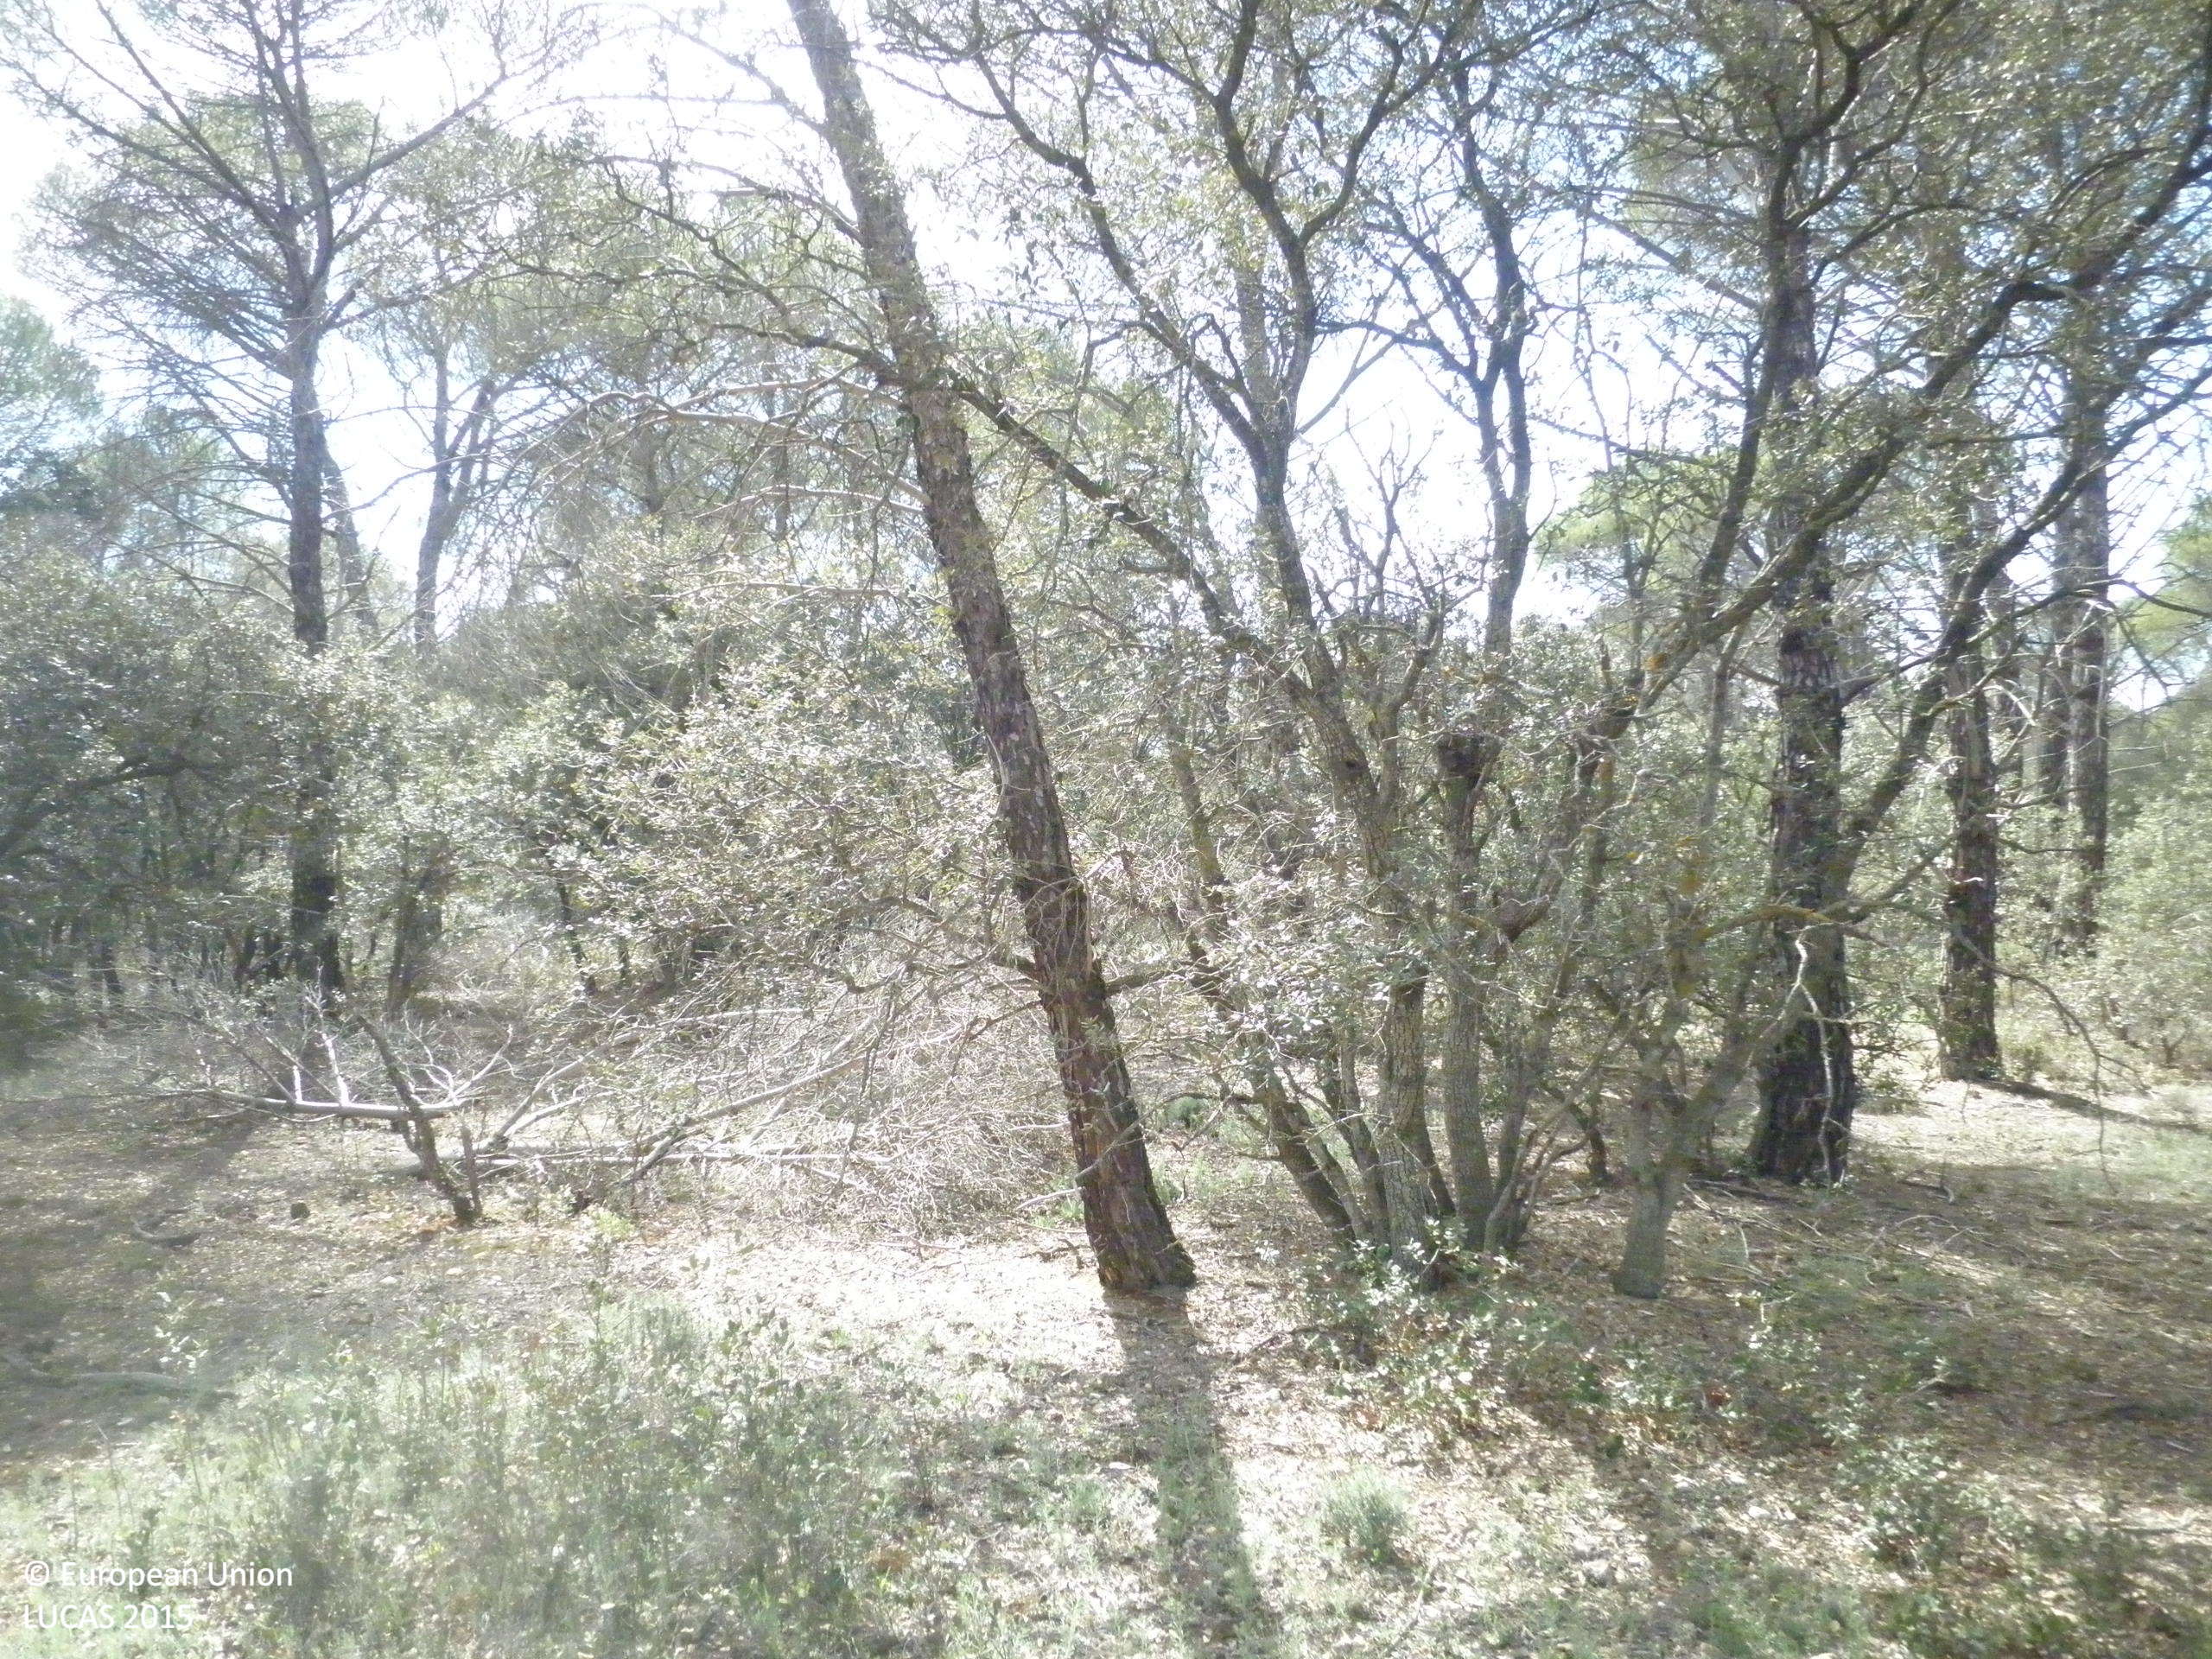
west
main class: Woodland
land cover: Pine dominated mixed woodland
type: coniferous forest of the mediterranean region
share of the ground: > 75 %
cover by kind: coniferous forest trees 45 %, broadleaved forest trees 25 %, shrubs 10 %, herbaceous plants 10 %, unconsolidated bare surface 10 %
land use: Semi-natural and natural areas not in use
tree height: > 5 m
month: April
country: ES
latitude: 39.3714
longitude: -2.6526
